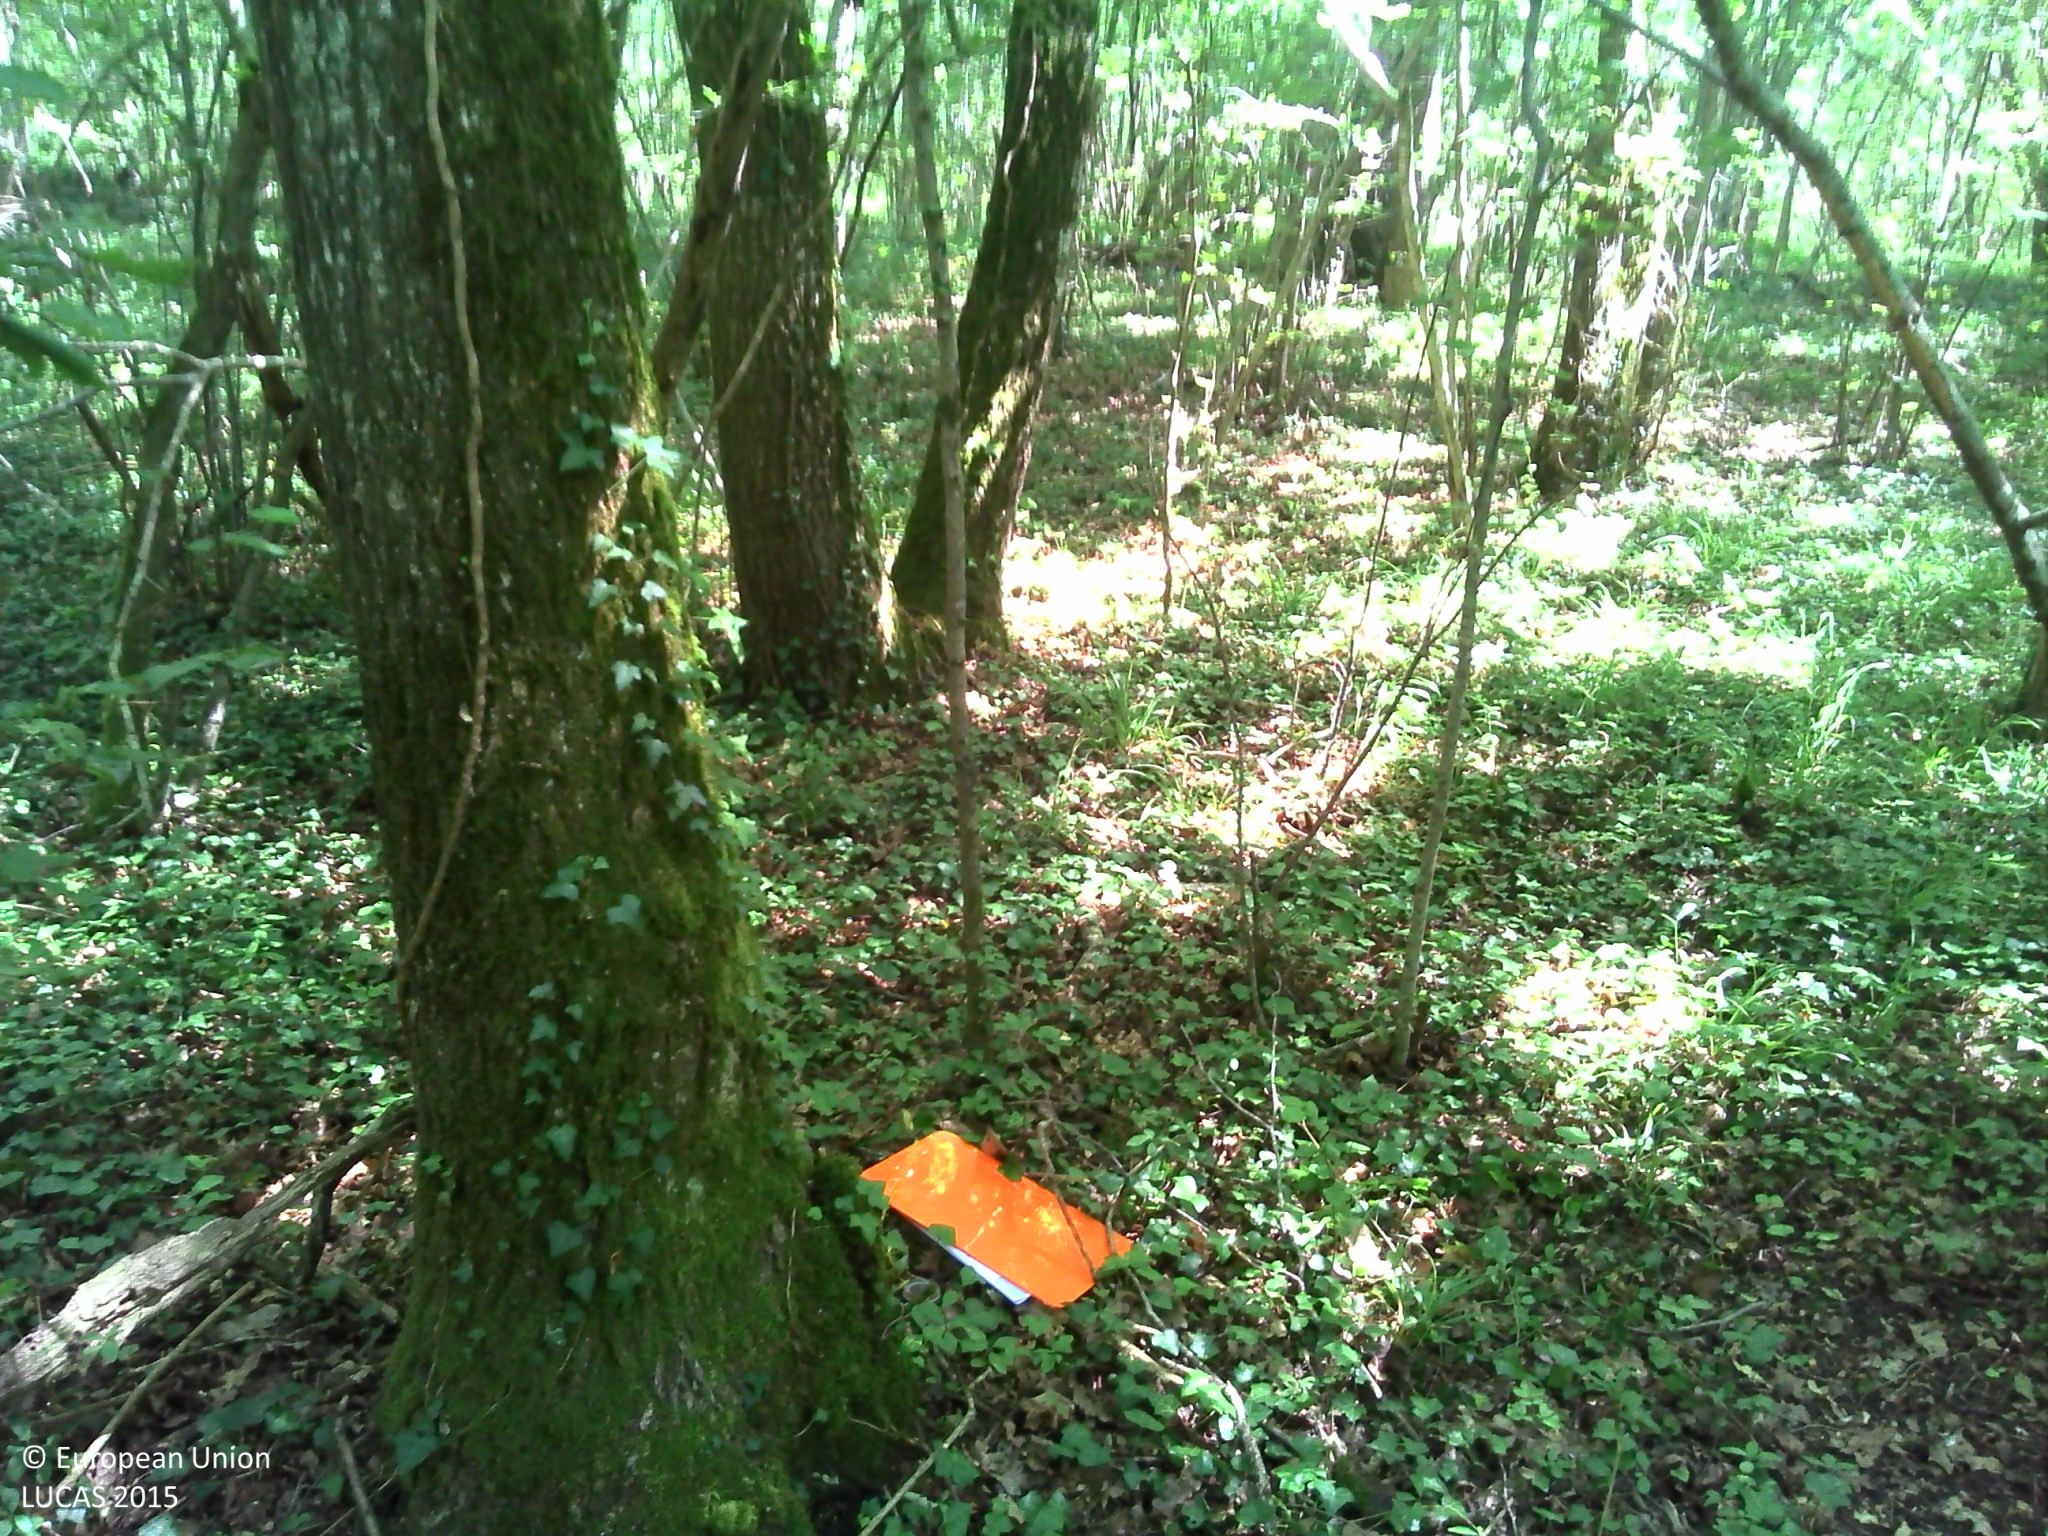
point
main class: Woodland
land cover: Broadleaved woodland
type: mesophytic deciduous forest
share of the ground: > 75 %
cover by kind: broadleaved forest trees 100 %
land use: Forestry
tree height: > 5 m
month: July
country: FR
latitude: 48.0039
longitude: 2.4979
